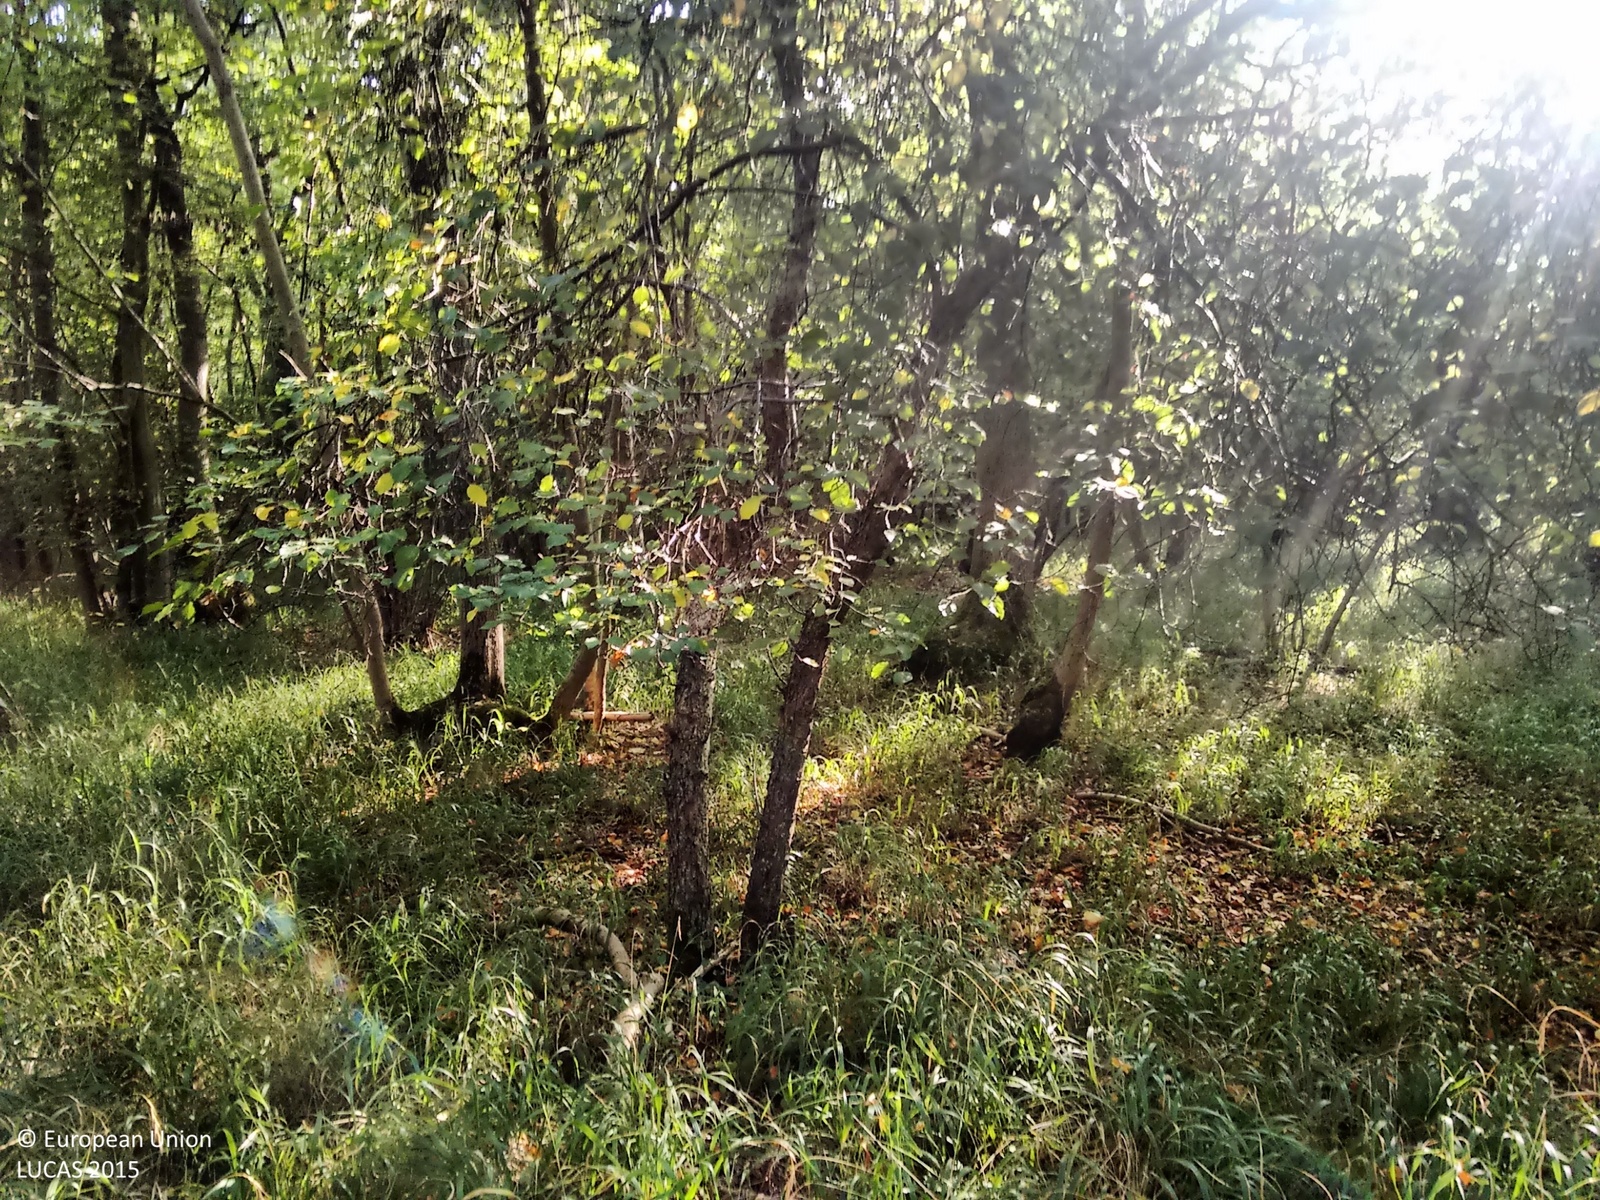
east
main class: Woodland
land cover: Broadleaved woodland
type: mesophytic deciduous forest
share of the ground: > 75 %
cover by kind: broadleaved forest trees 75 %, shrubs 25 %
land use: Amenities, museums, leisure
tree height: > 5 m
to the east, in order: Broadleaved woodland
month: October
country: GB
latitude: 52.4038
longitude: -0.2509
